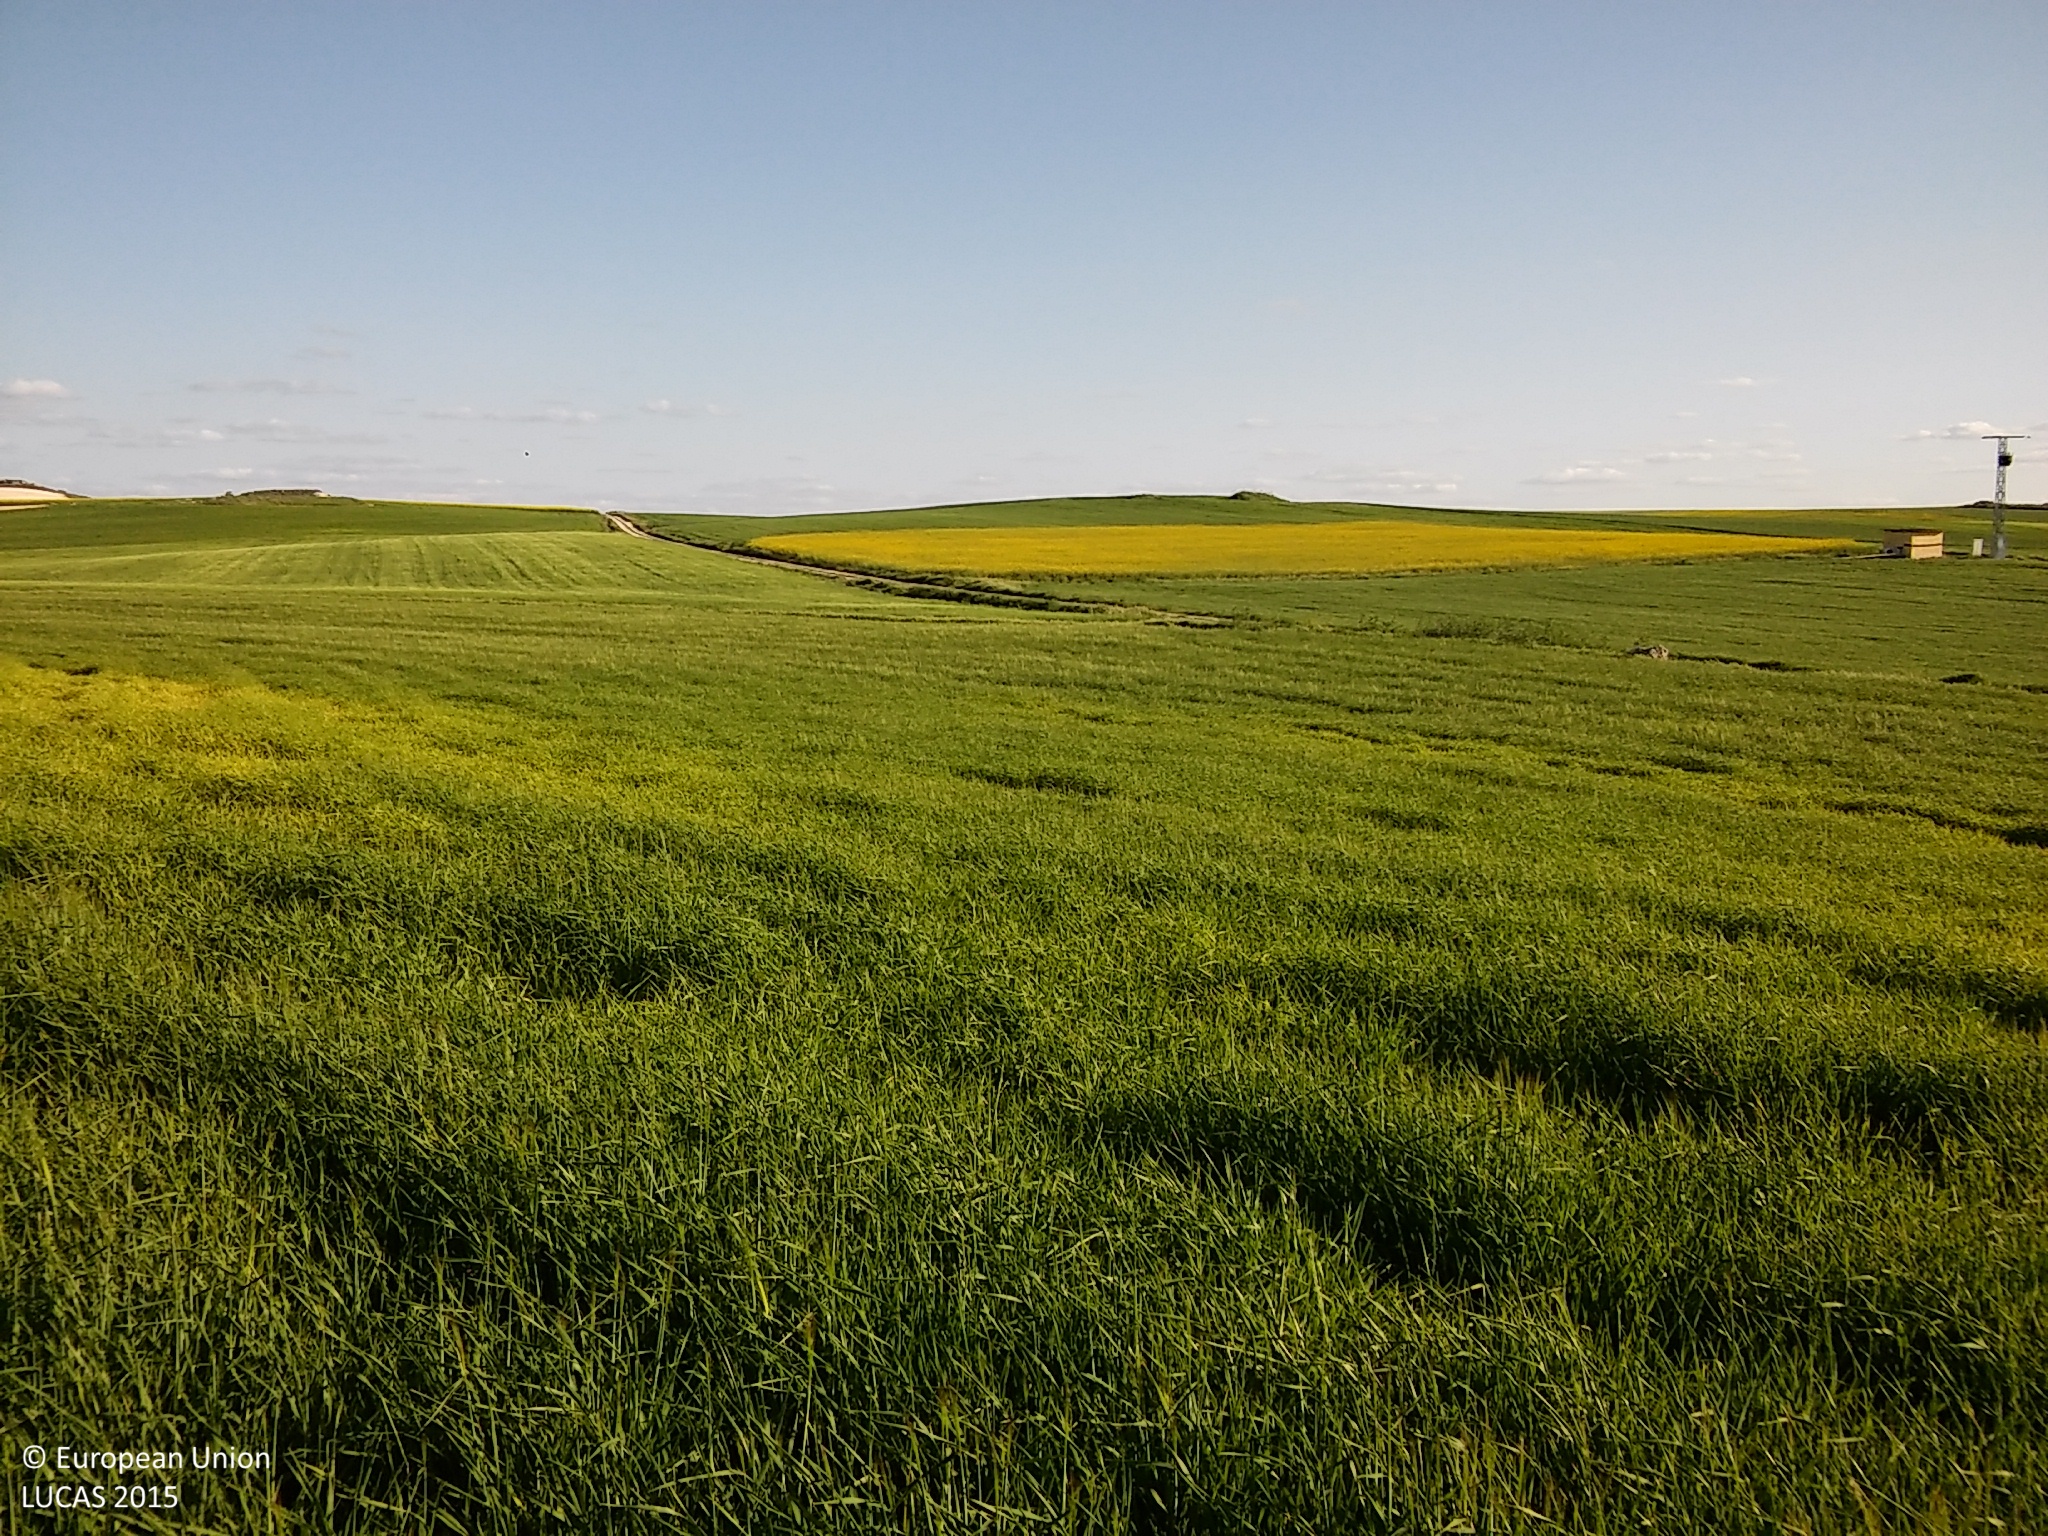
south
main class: Cropland
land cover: Barley
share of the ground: 25 - 50 %
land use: Agriculture (excluding fallow land and kitchen gardens)
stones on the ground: 25 - 50 %
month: May
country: ES
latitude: 41.4430
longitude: -4.0958
